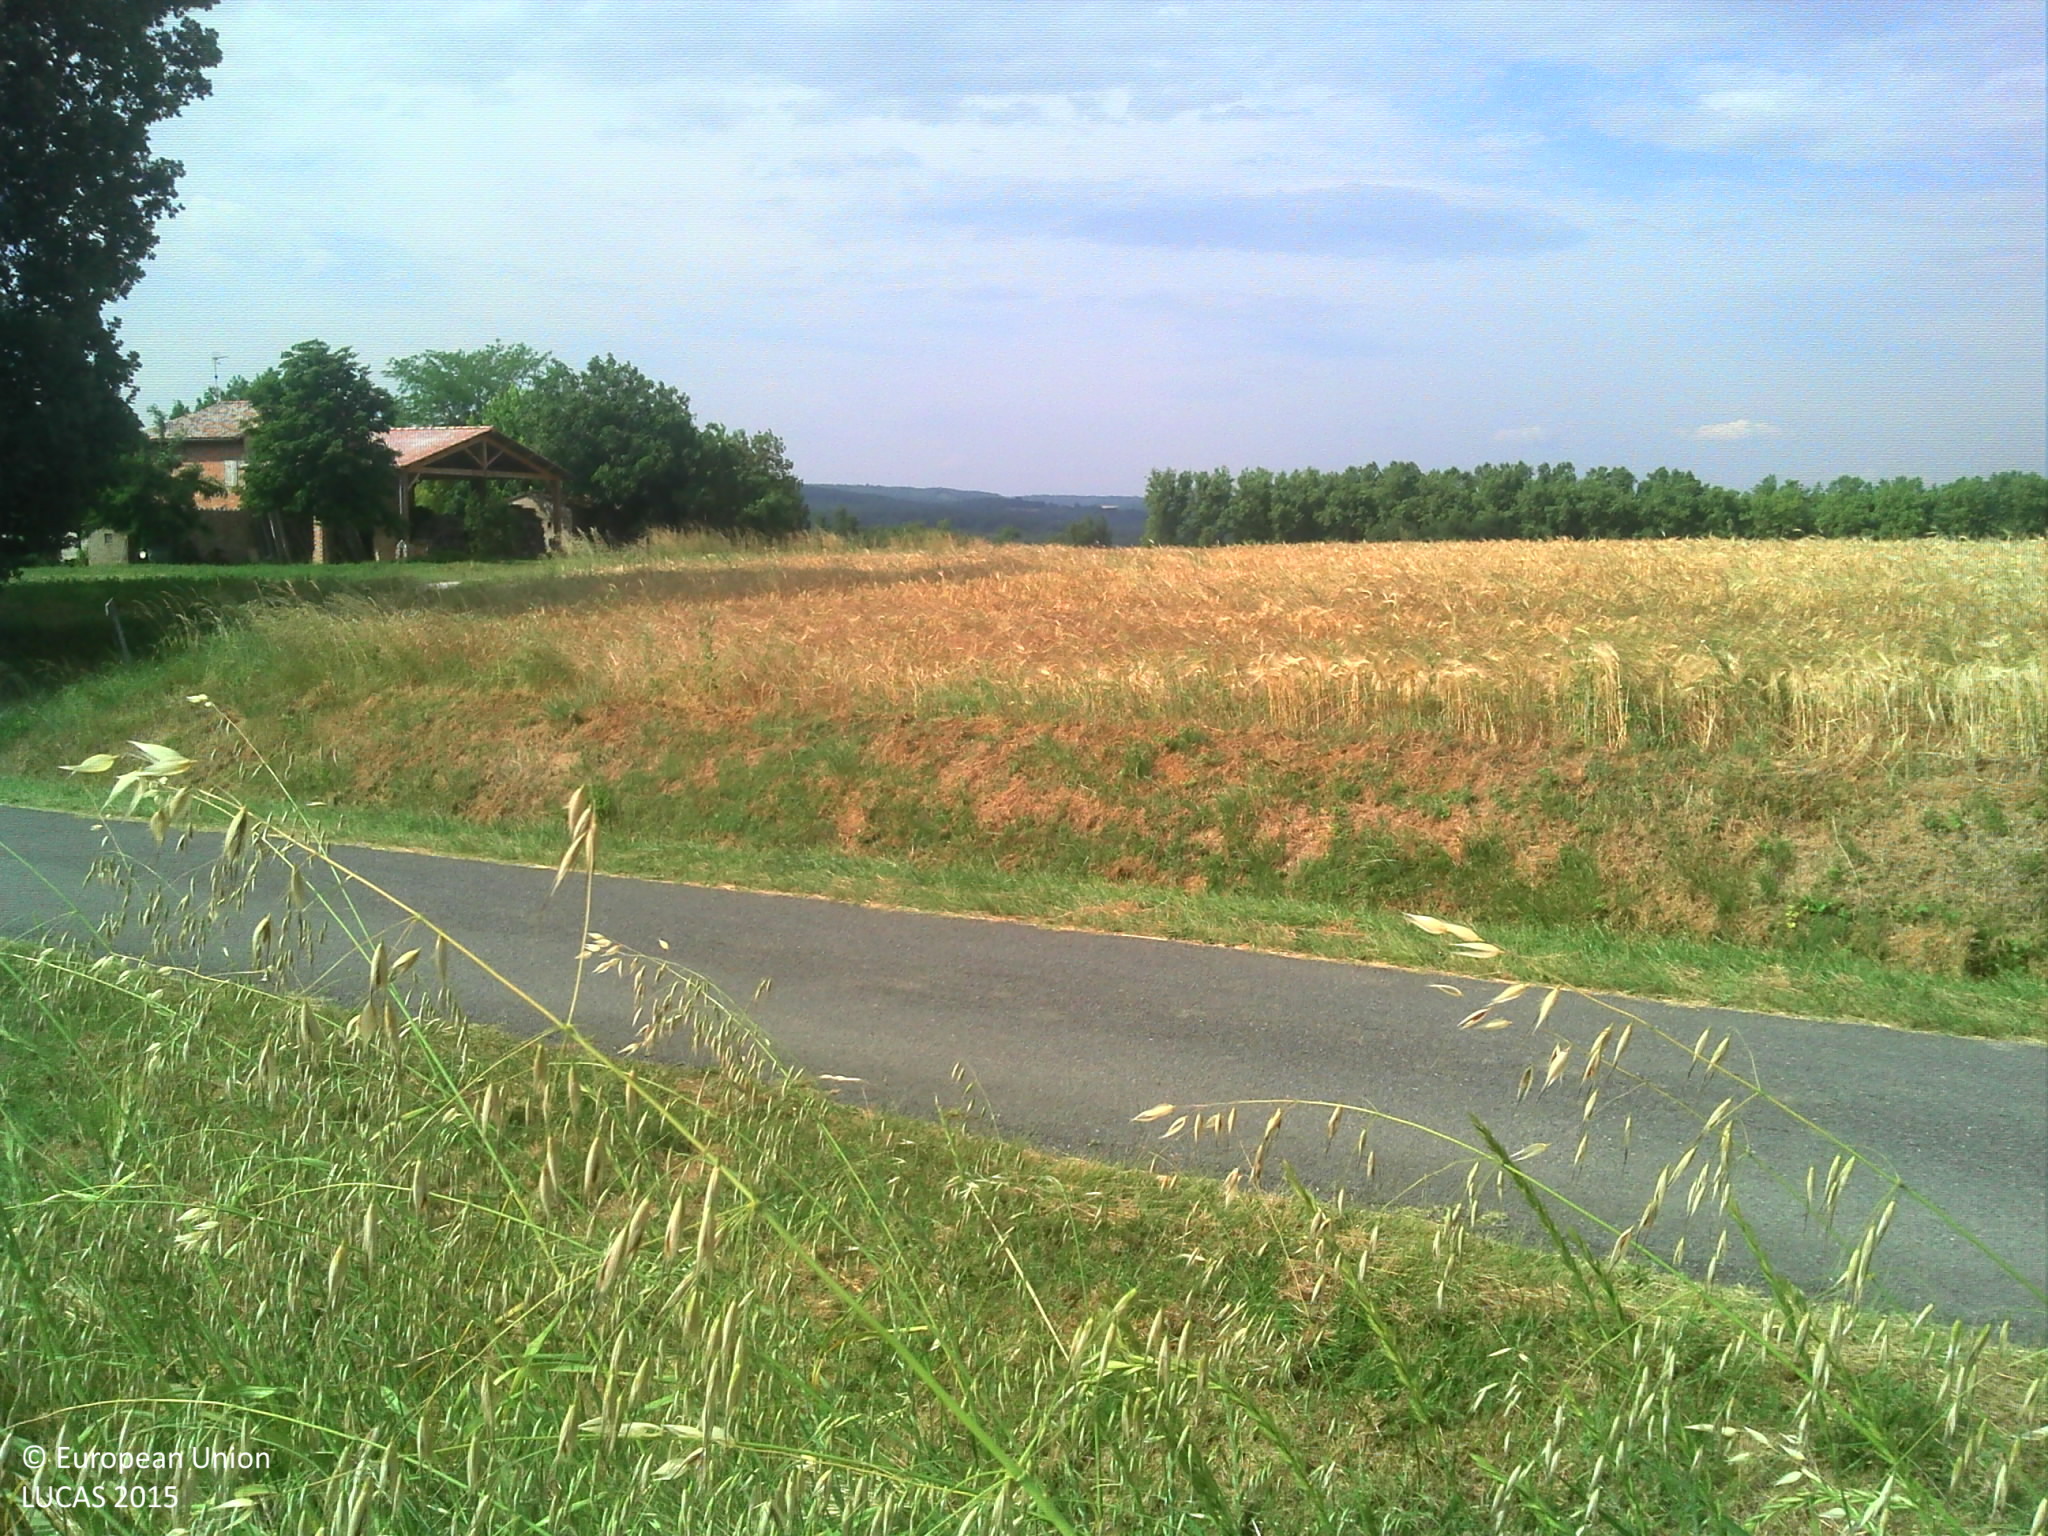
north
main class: Cropland
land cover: Barley
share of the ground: > 75 %
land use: Agriculture (excluding fallow land and kitchen gardens)
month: June
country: FR
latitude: 43.6415
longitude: 1.9841
